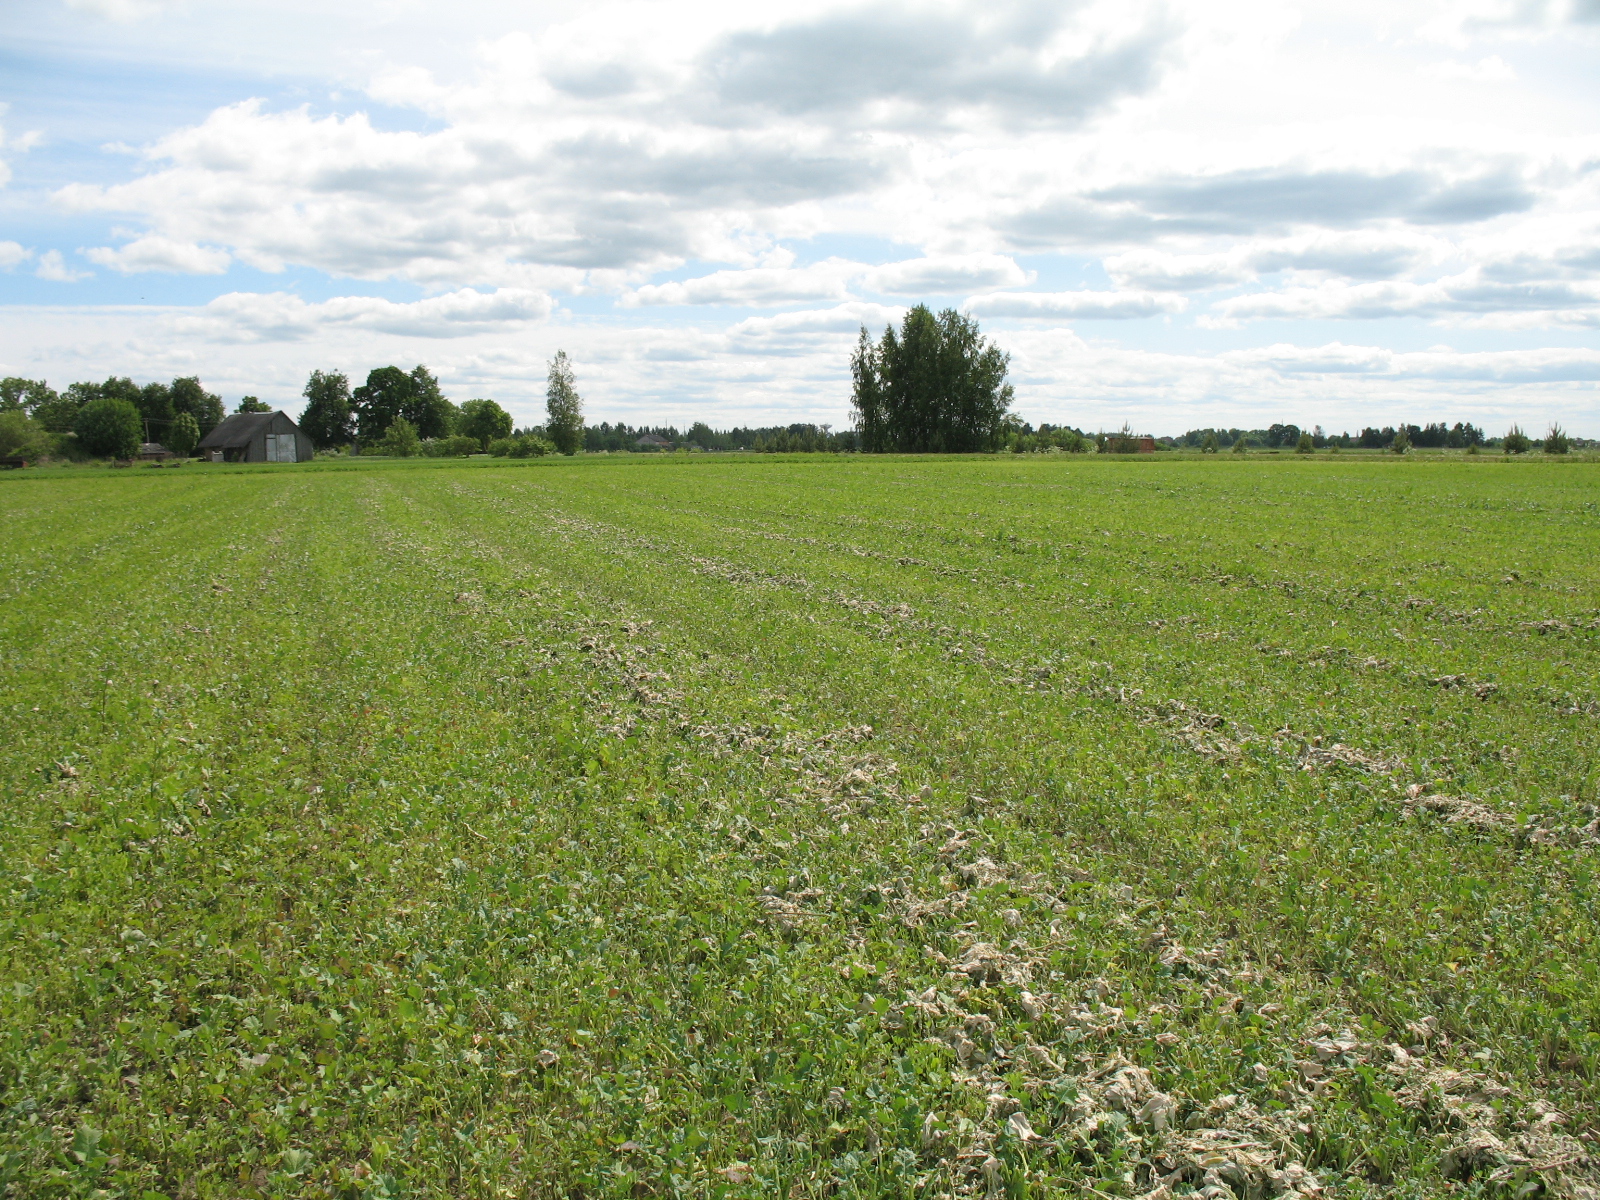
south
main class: Cropland
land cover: Rape and turnip rape
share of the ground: > 75 %
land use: Agriculture (excluding fallow land and kitchen gardens)
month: June
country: LV
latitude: 56.6428
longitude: 23.4615
